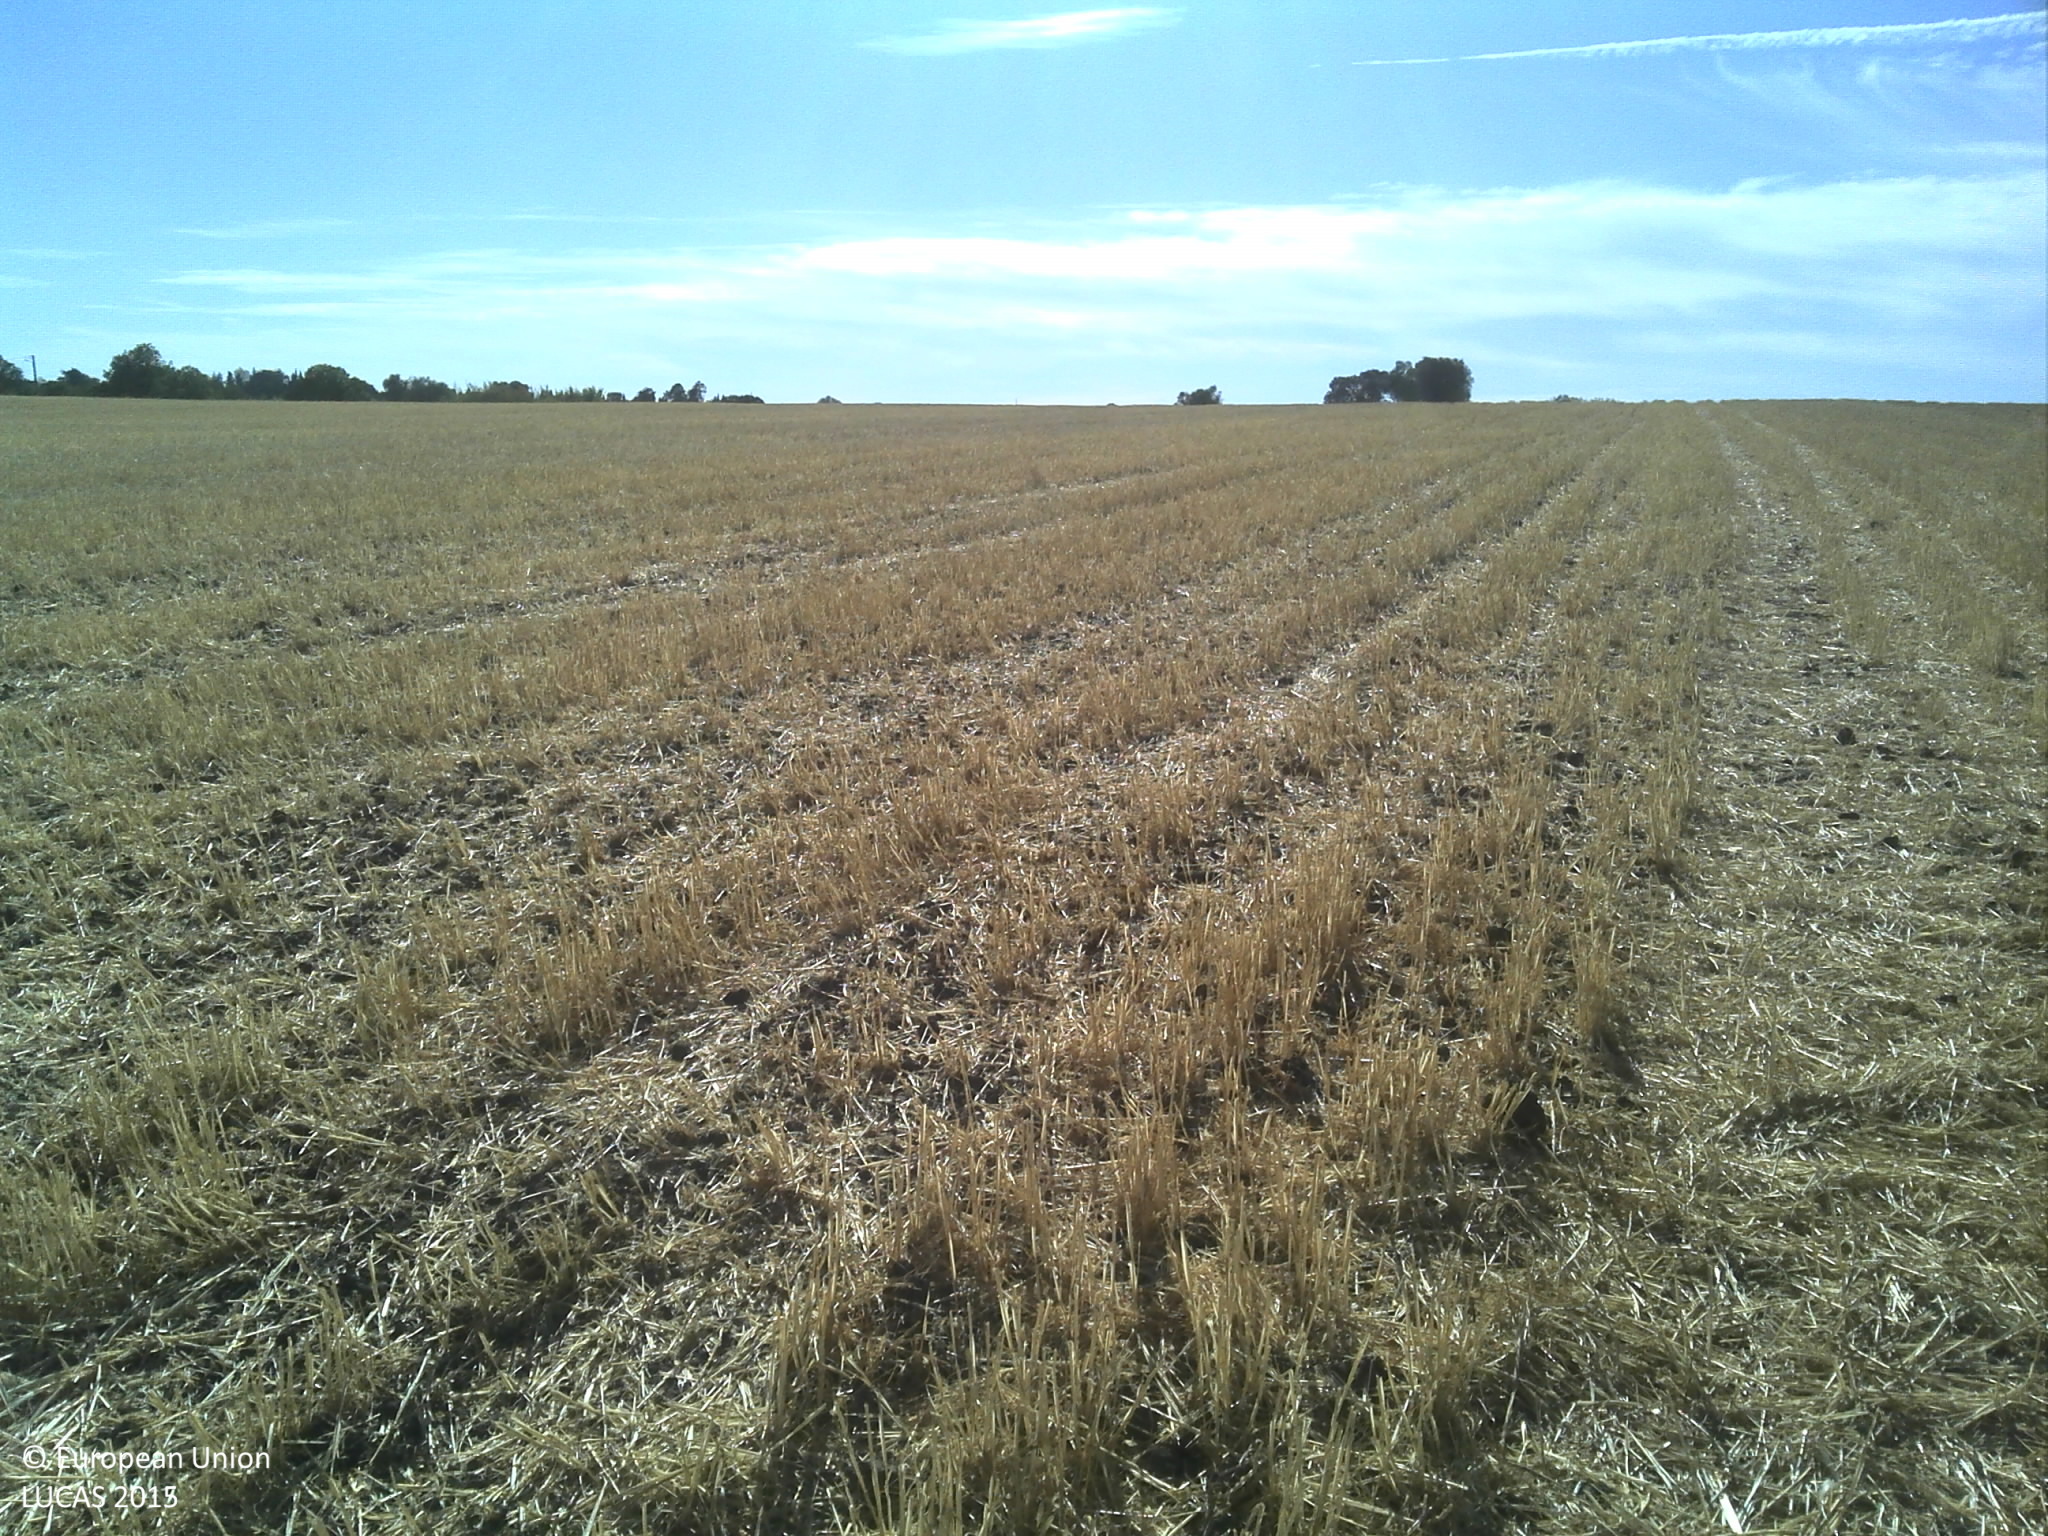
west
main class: Cropland
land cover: Barley
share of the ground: > 75 %
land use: Agriculture (excluding fallow land and kitchen gardens)
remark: Harvested field
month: July
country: PT
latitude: 38.0404
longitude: -7.8601
